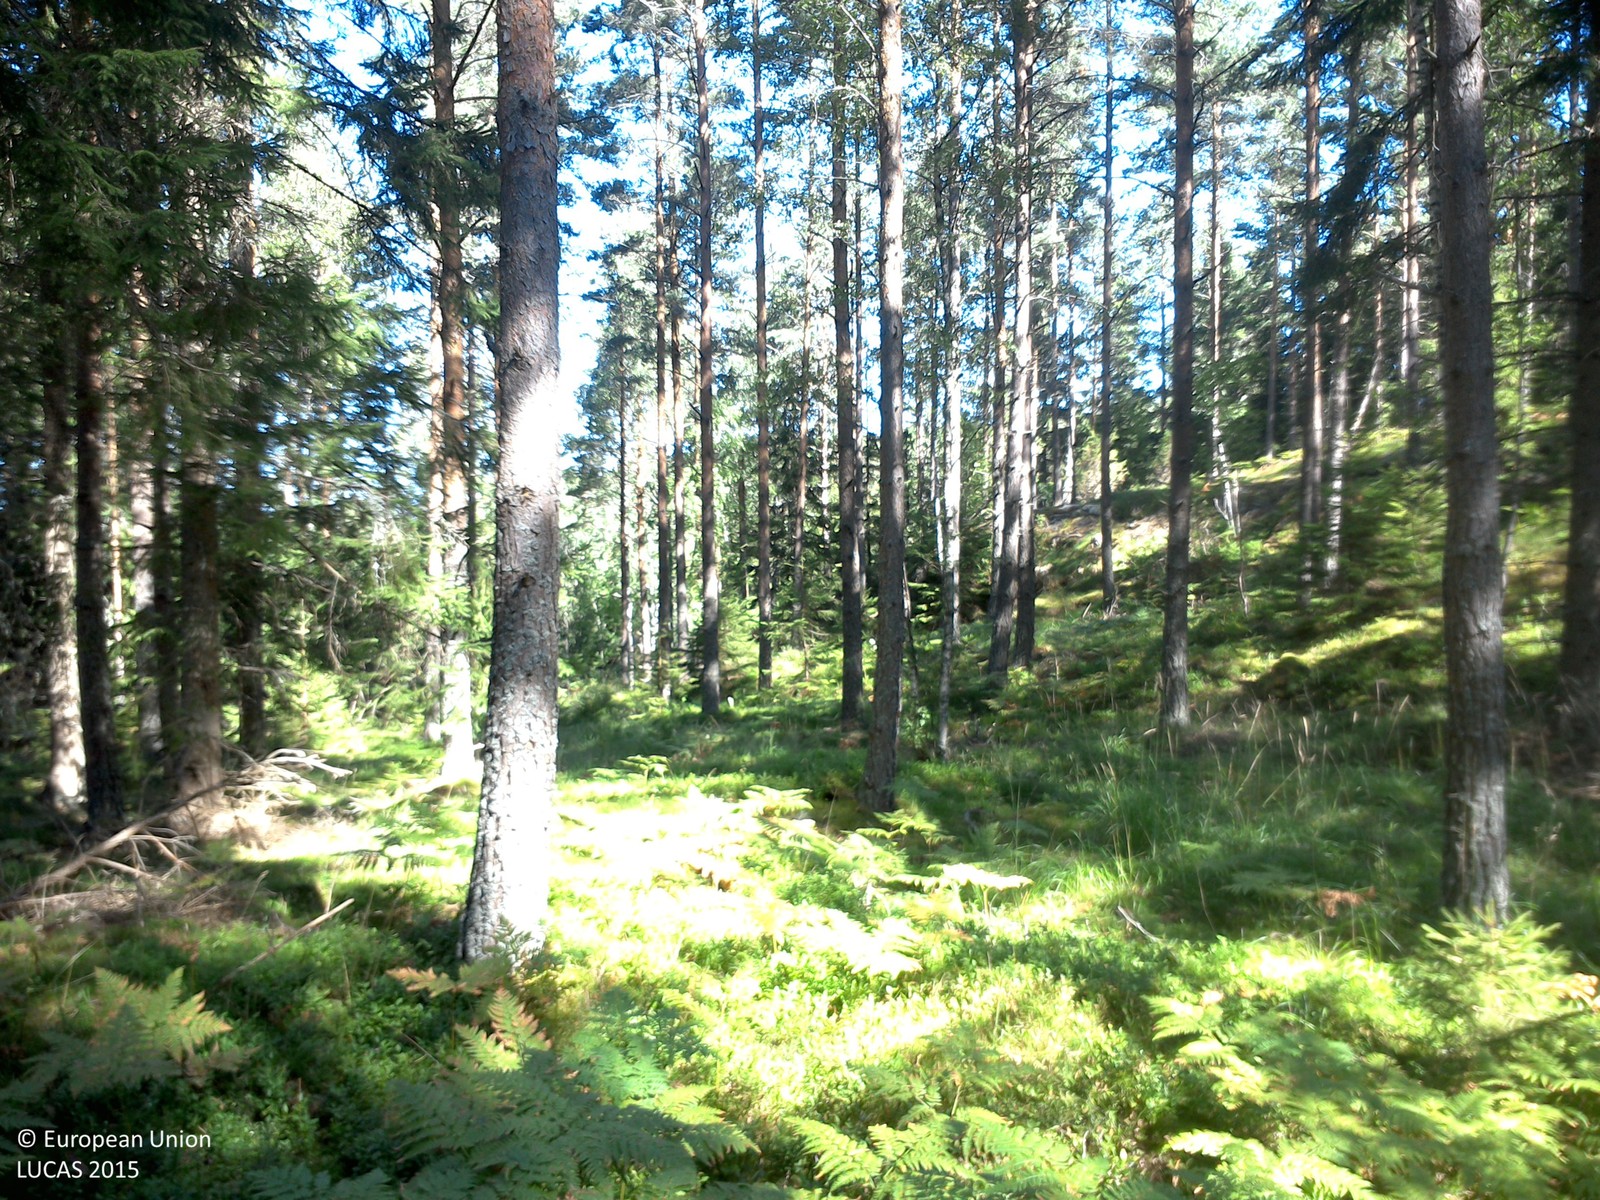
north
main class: Woodland
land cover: Pine dominated coniferous woodland
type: boreal forest
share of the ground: 25 - 50 %
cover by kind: coniferous forest trees 40 %, herbaceous plants 40 %, lichens and mosses 20 %
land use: Forestry
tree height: > 5 m
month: August
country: SE
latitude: 57.8777
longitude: 15.3746
